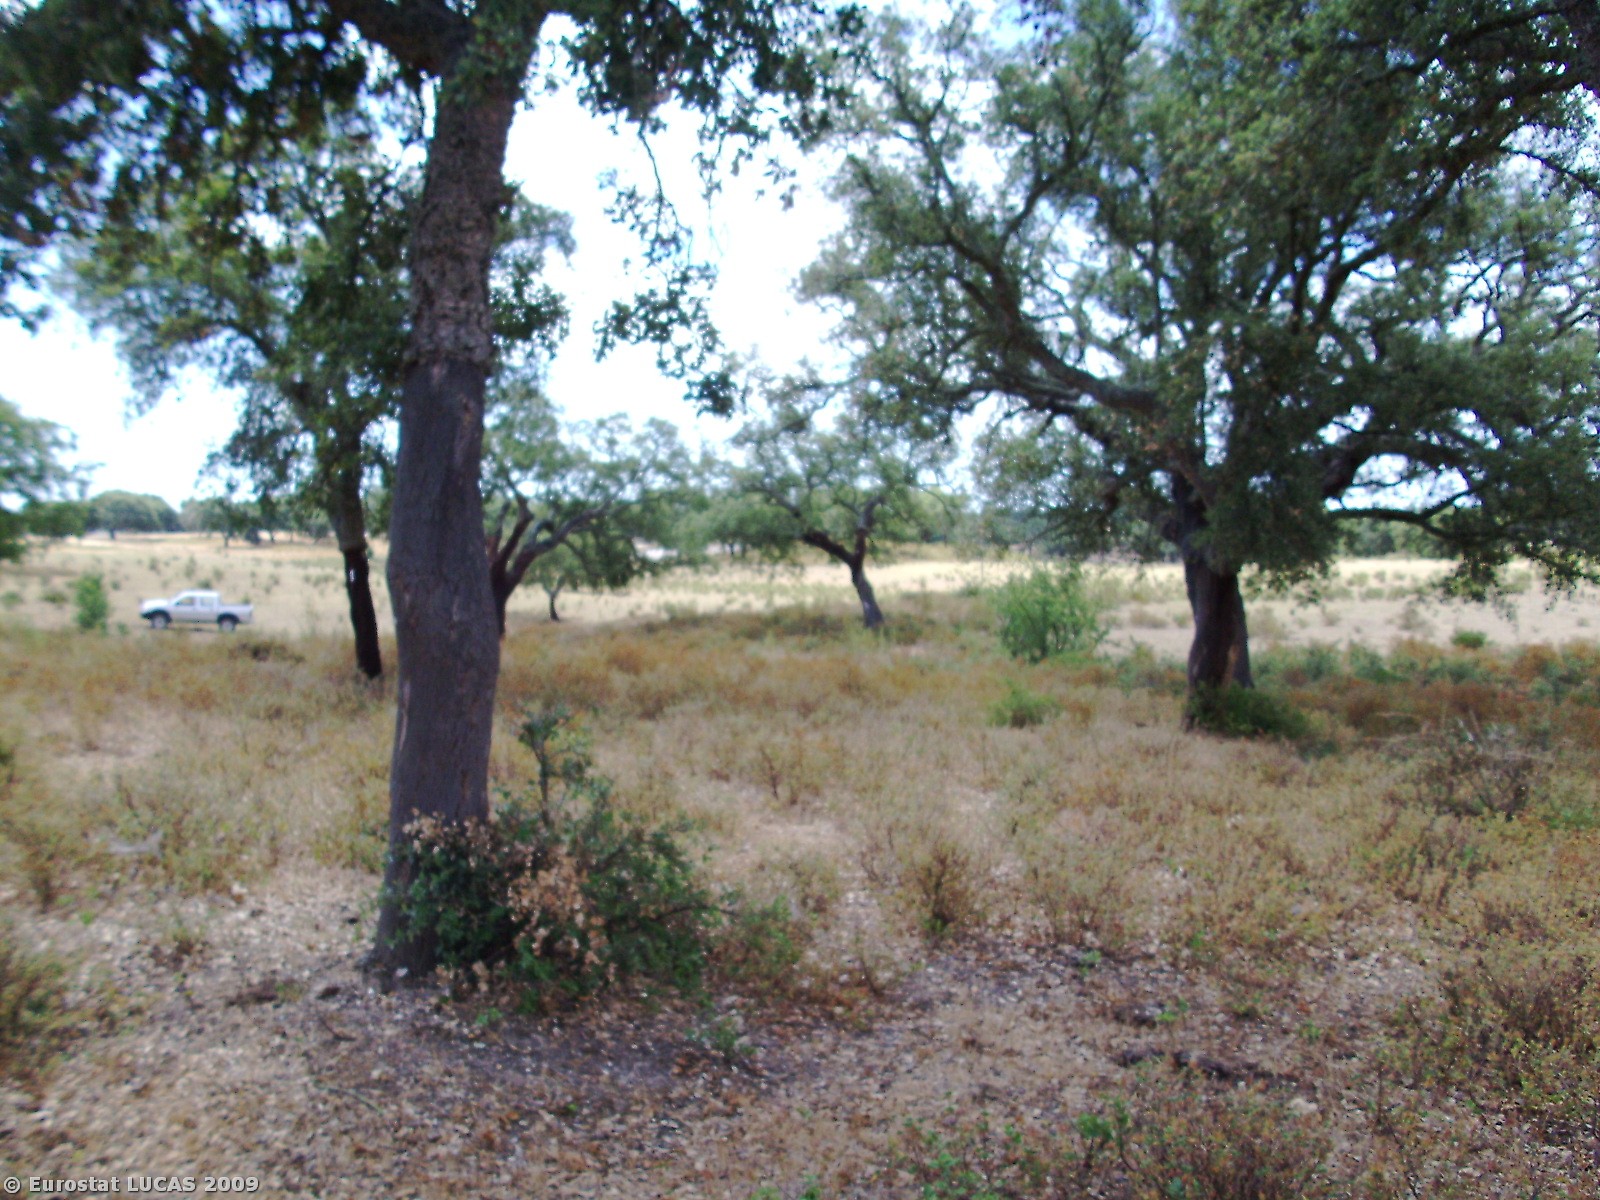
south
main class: Woodland
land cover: Broadleaved woodland
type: broadleaved evergreen forest
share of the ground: 10 - 25 %
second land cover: Shrubland with sparse tree cover
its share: 50 - 75 %
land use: Forestry
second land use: Agriculture (excluding fallow land and kitchen gardens)
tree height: > 5 m
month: June
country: PT
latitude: 37.9906
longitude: -8.5003
